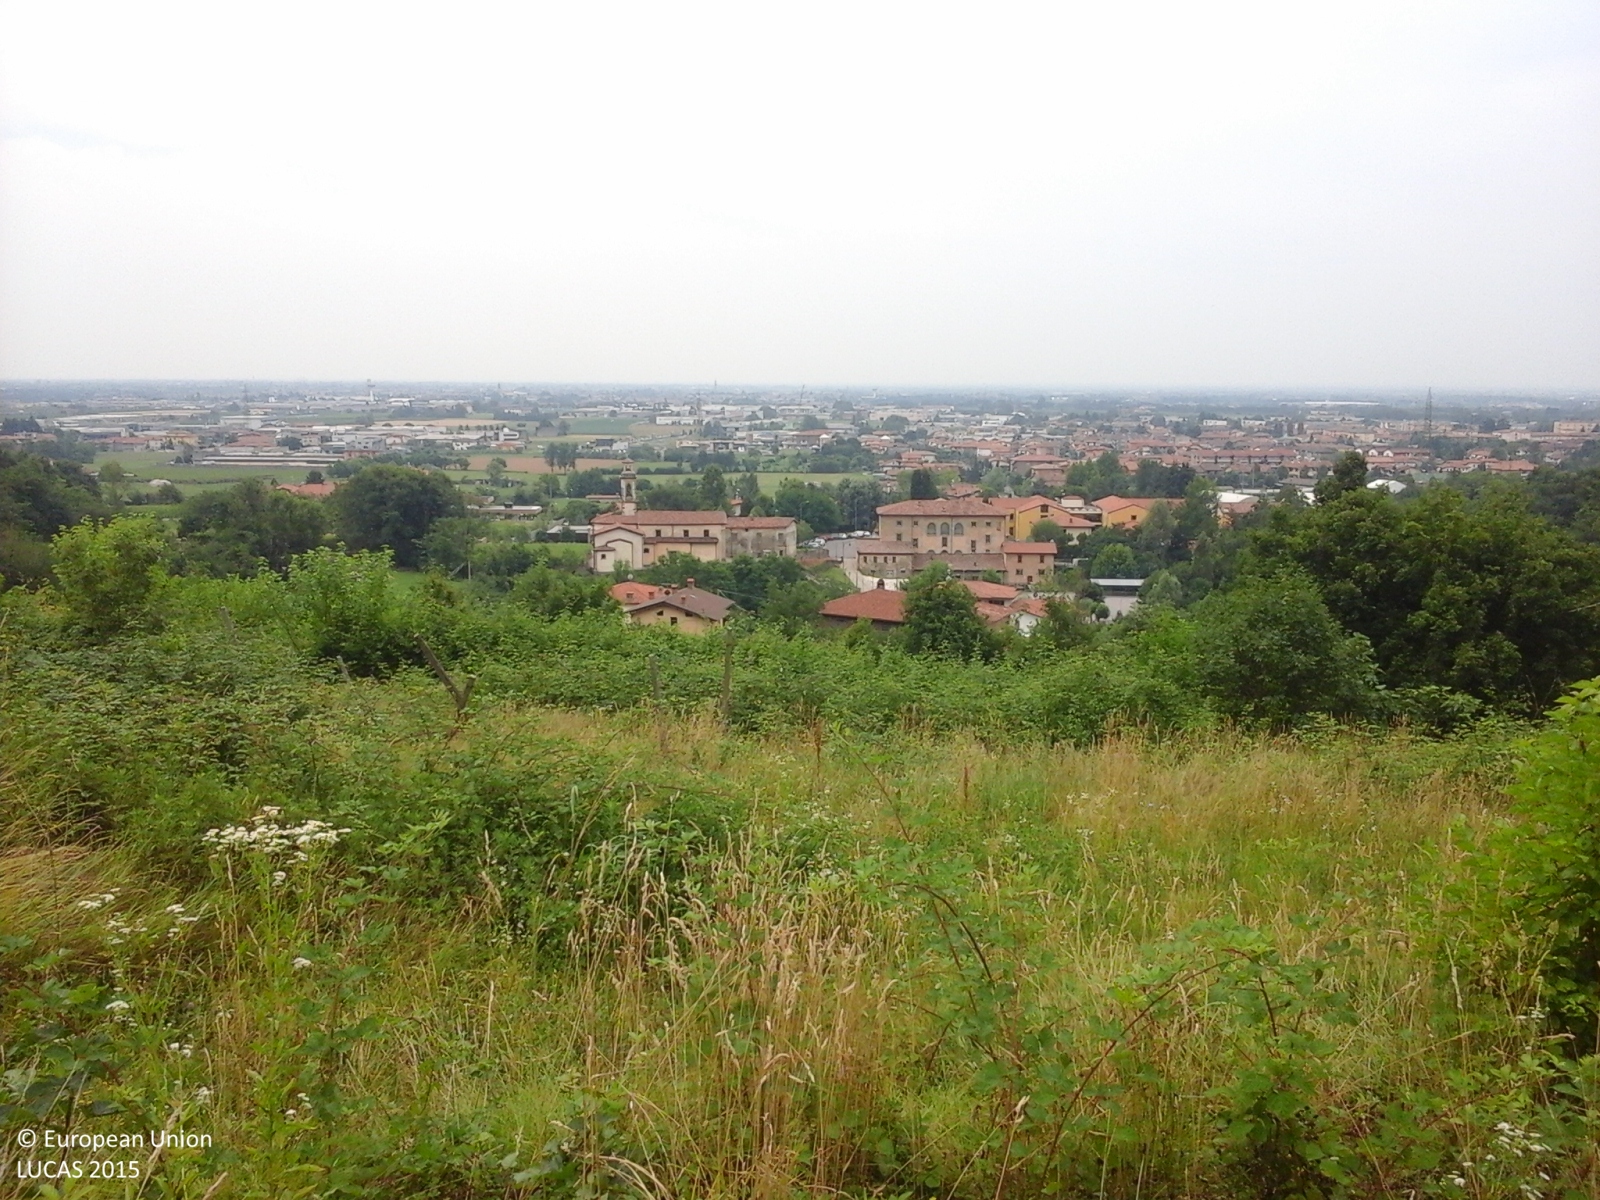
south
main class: Grassland
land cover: Spontaneously vegetated surfaces
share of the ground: > 75 %
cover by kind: herbaceous plants 100 %
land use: Abandoned areas
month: June
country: IT
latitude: 45.6485
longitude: 9.8847
